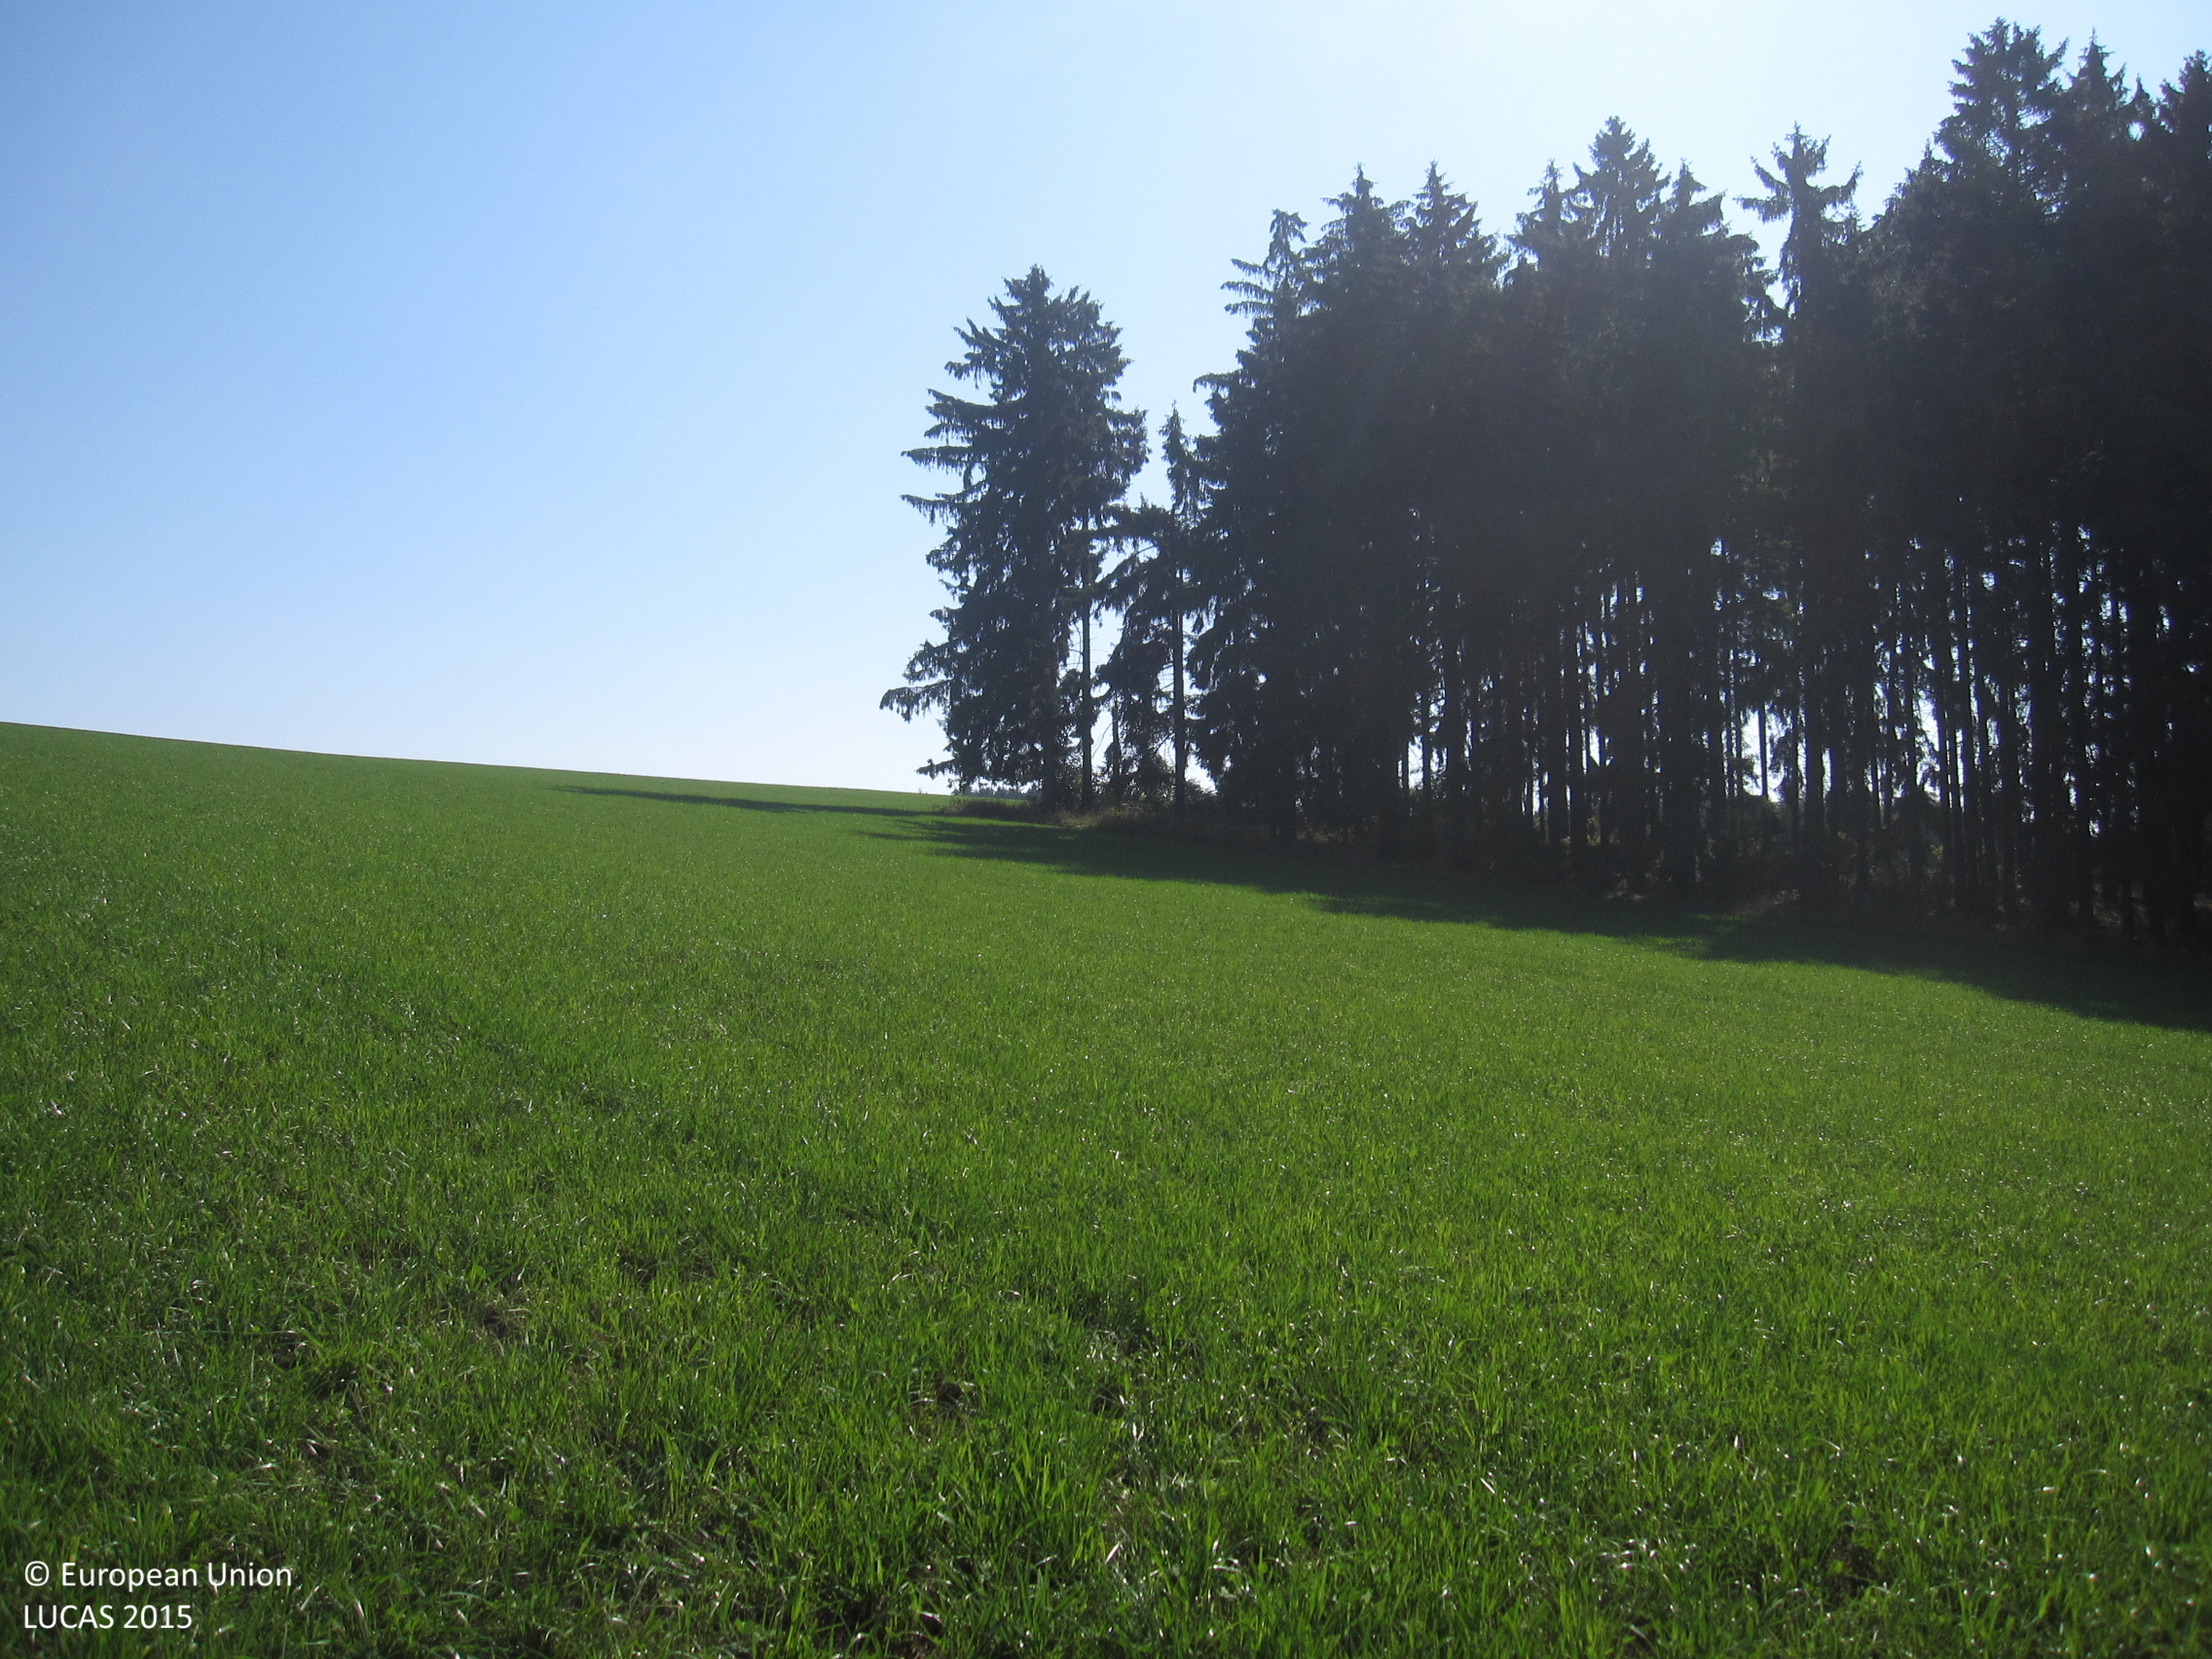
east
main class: Cropland
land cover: Temporary grasslands
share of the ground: > 75 %
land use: Agriculture (excluding fallow land and kitchen gardens)
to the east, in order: Temporary grasslands
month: August
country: DE
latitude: 50.5508
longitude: 11.5945
